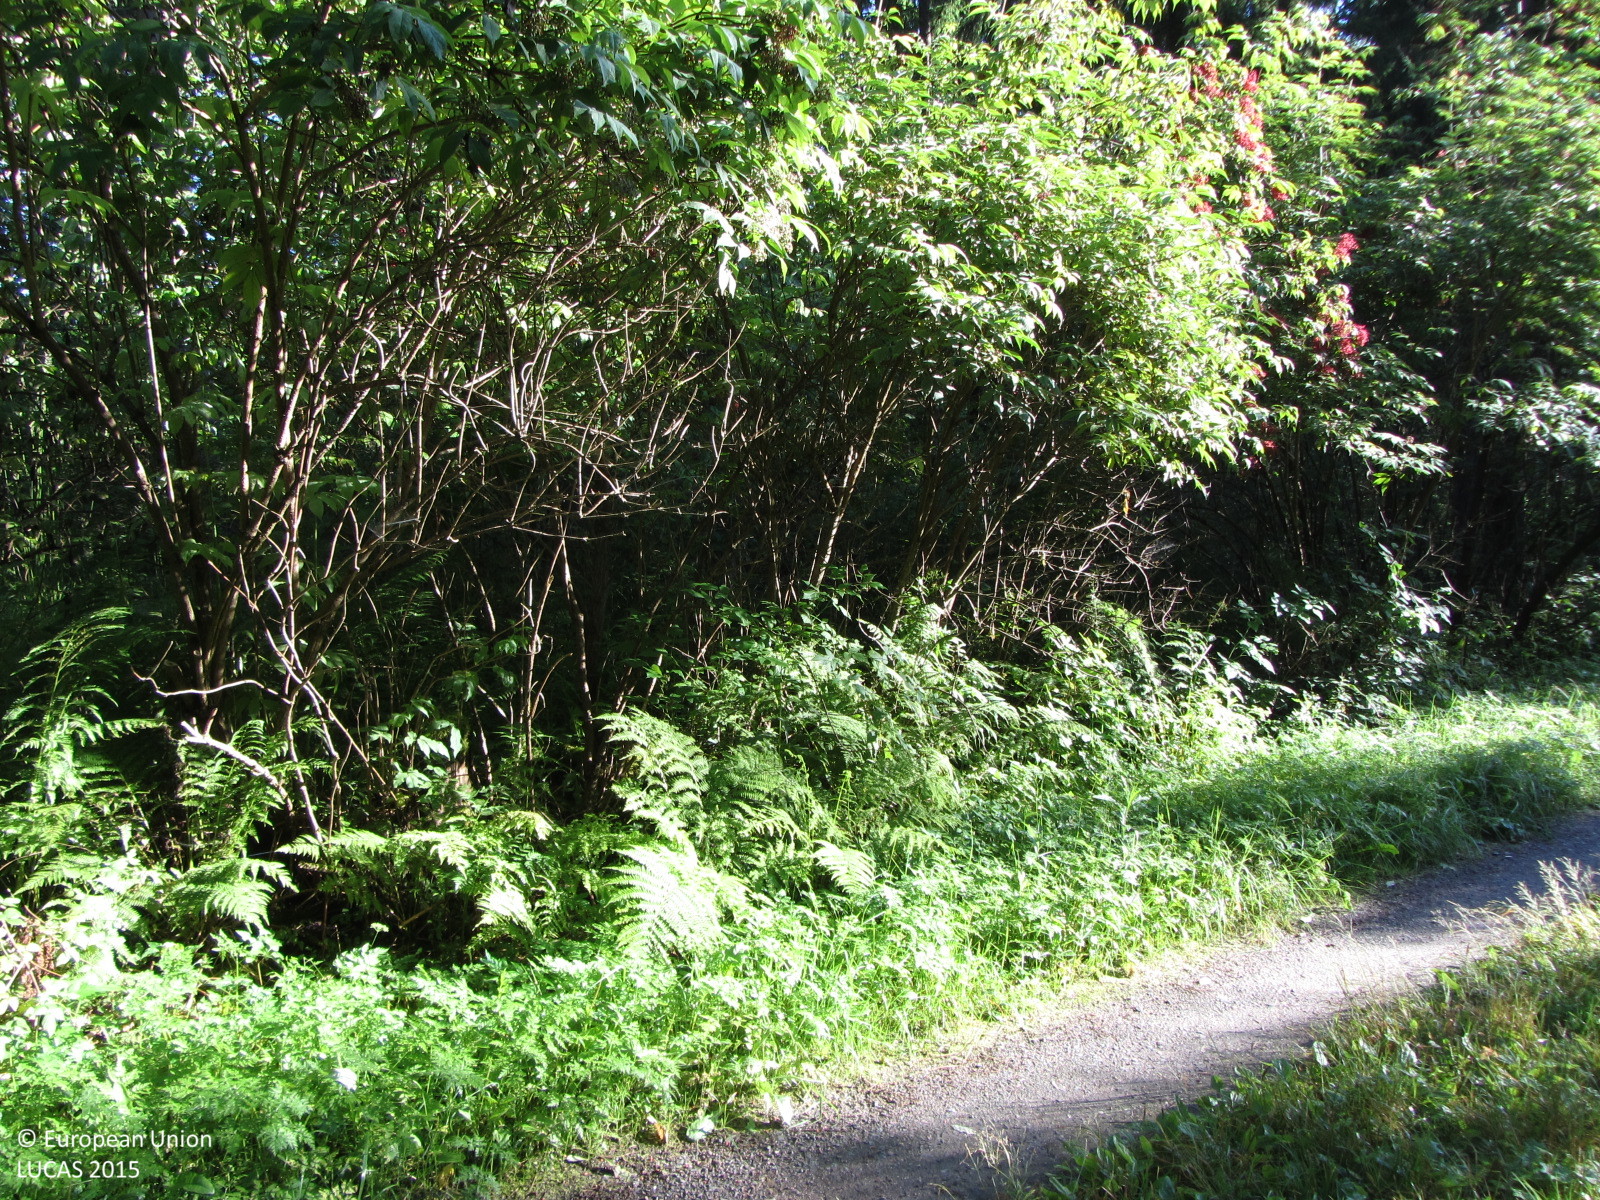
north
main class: Woodland
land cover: Spruce dominated coniferous woodland
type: boreal forest
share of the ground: 50 - 75 %
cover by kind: coniferous forest trees 70 %, herbaceous plants 20 %, broadleaved forest trees 10 %
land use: Forestry
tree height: > 5 m
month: July
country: FI
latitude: 60.6977
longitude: 24.4460
